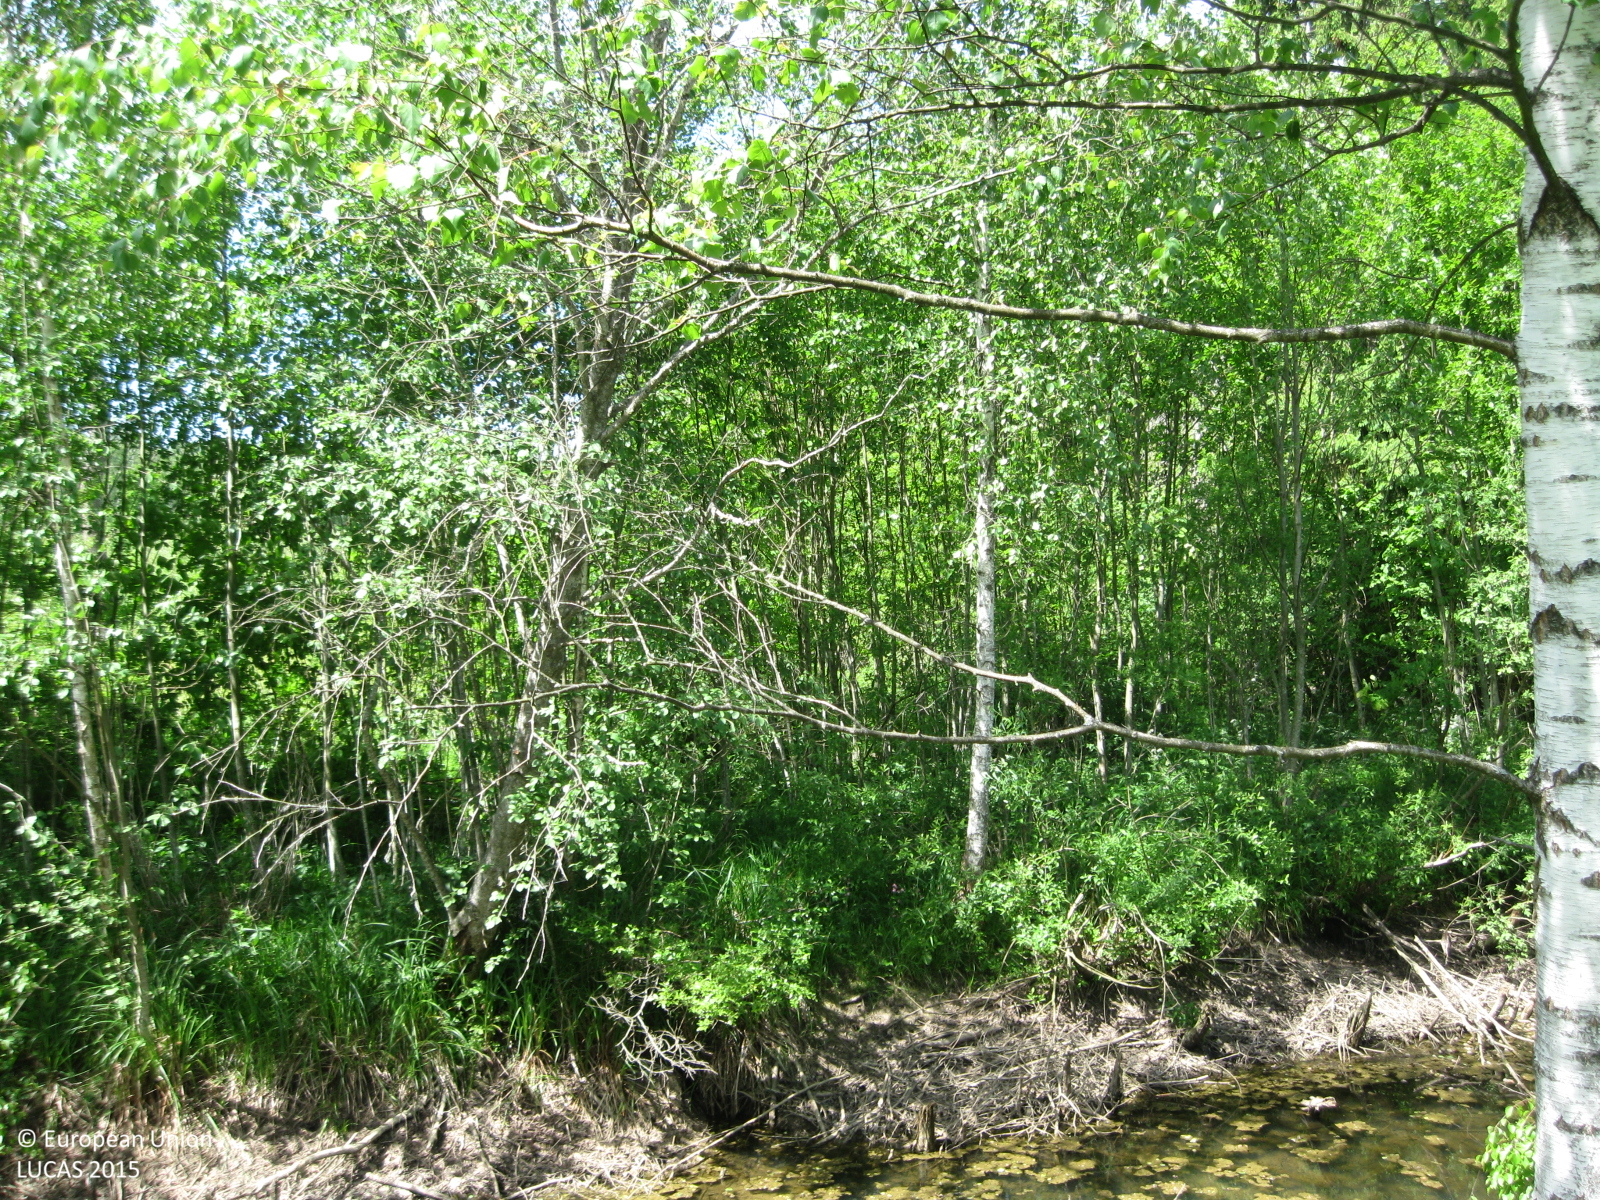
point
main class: Woodland
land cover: Broadleaved woodland
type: floodplain forest
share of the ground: > 75 %
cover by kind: broadleaved forest trees 70 %, coniferous forest trees 15 %, herbaceous plants 10 %, shrubs 5 %
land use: Forestry
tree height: > 5 m
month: June
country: LT
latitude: 55.6382
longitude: 23.6323
